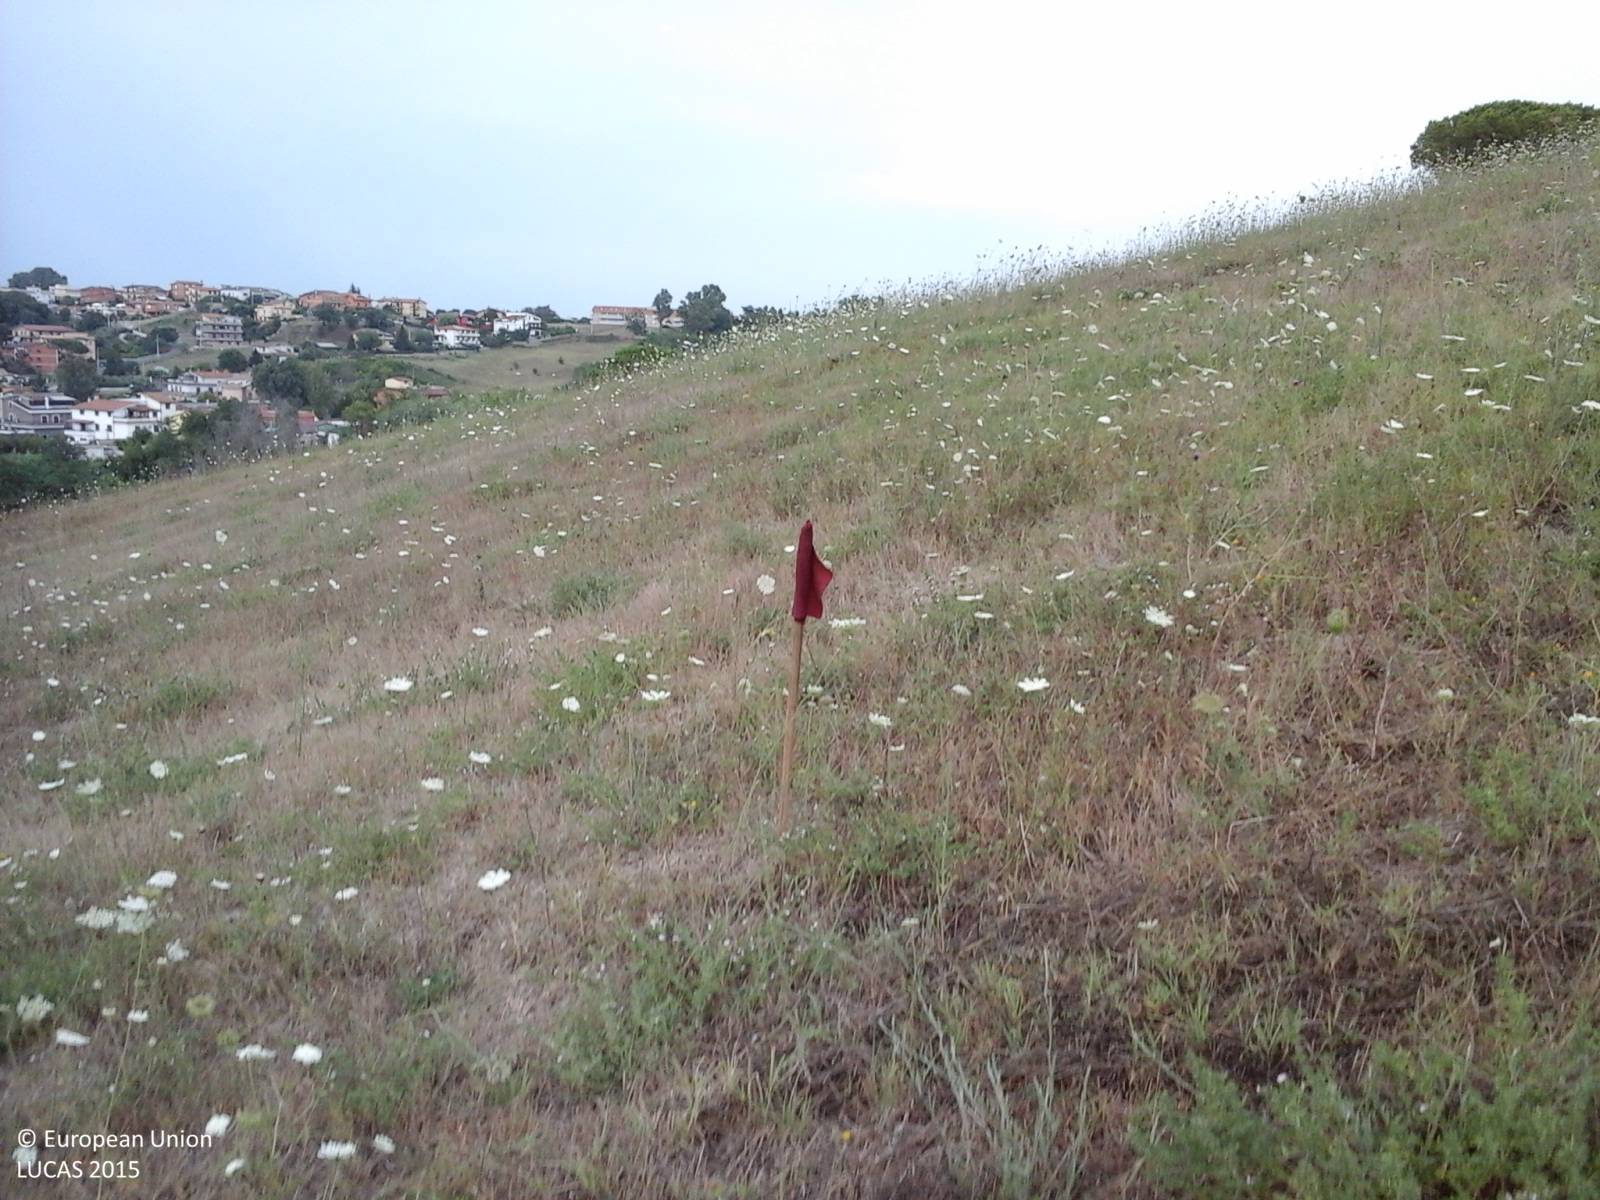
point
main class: Grassland
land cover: Grassland without tree/shrub cover
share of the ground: > 75 %
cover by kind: herbaceous plants 100 %
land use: Agriculture (excluding fallow land and kitchen gardens)
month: July
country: IT
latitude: 41.9402
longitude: 12.3432
